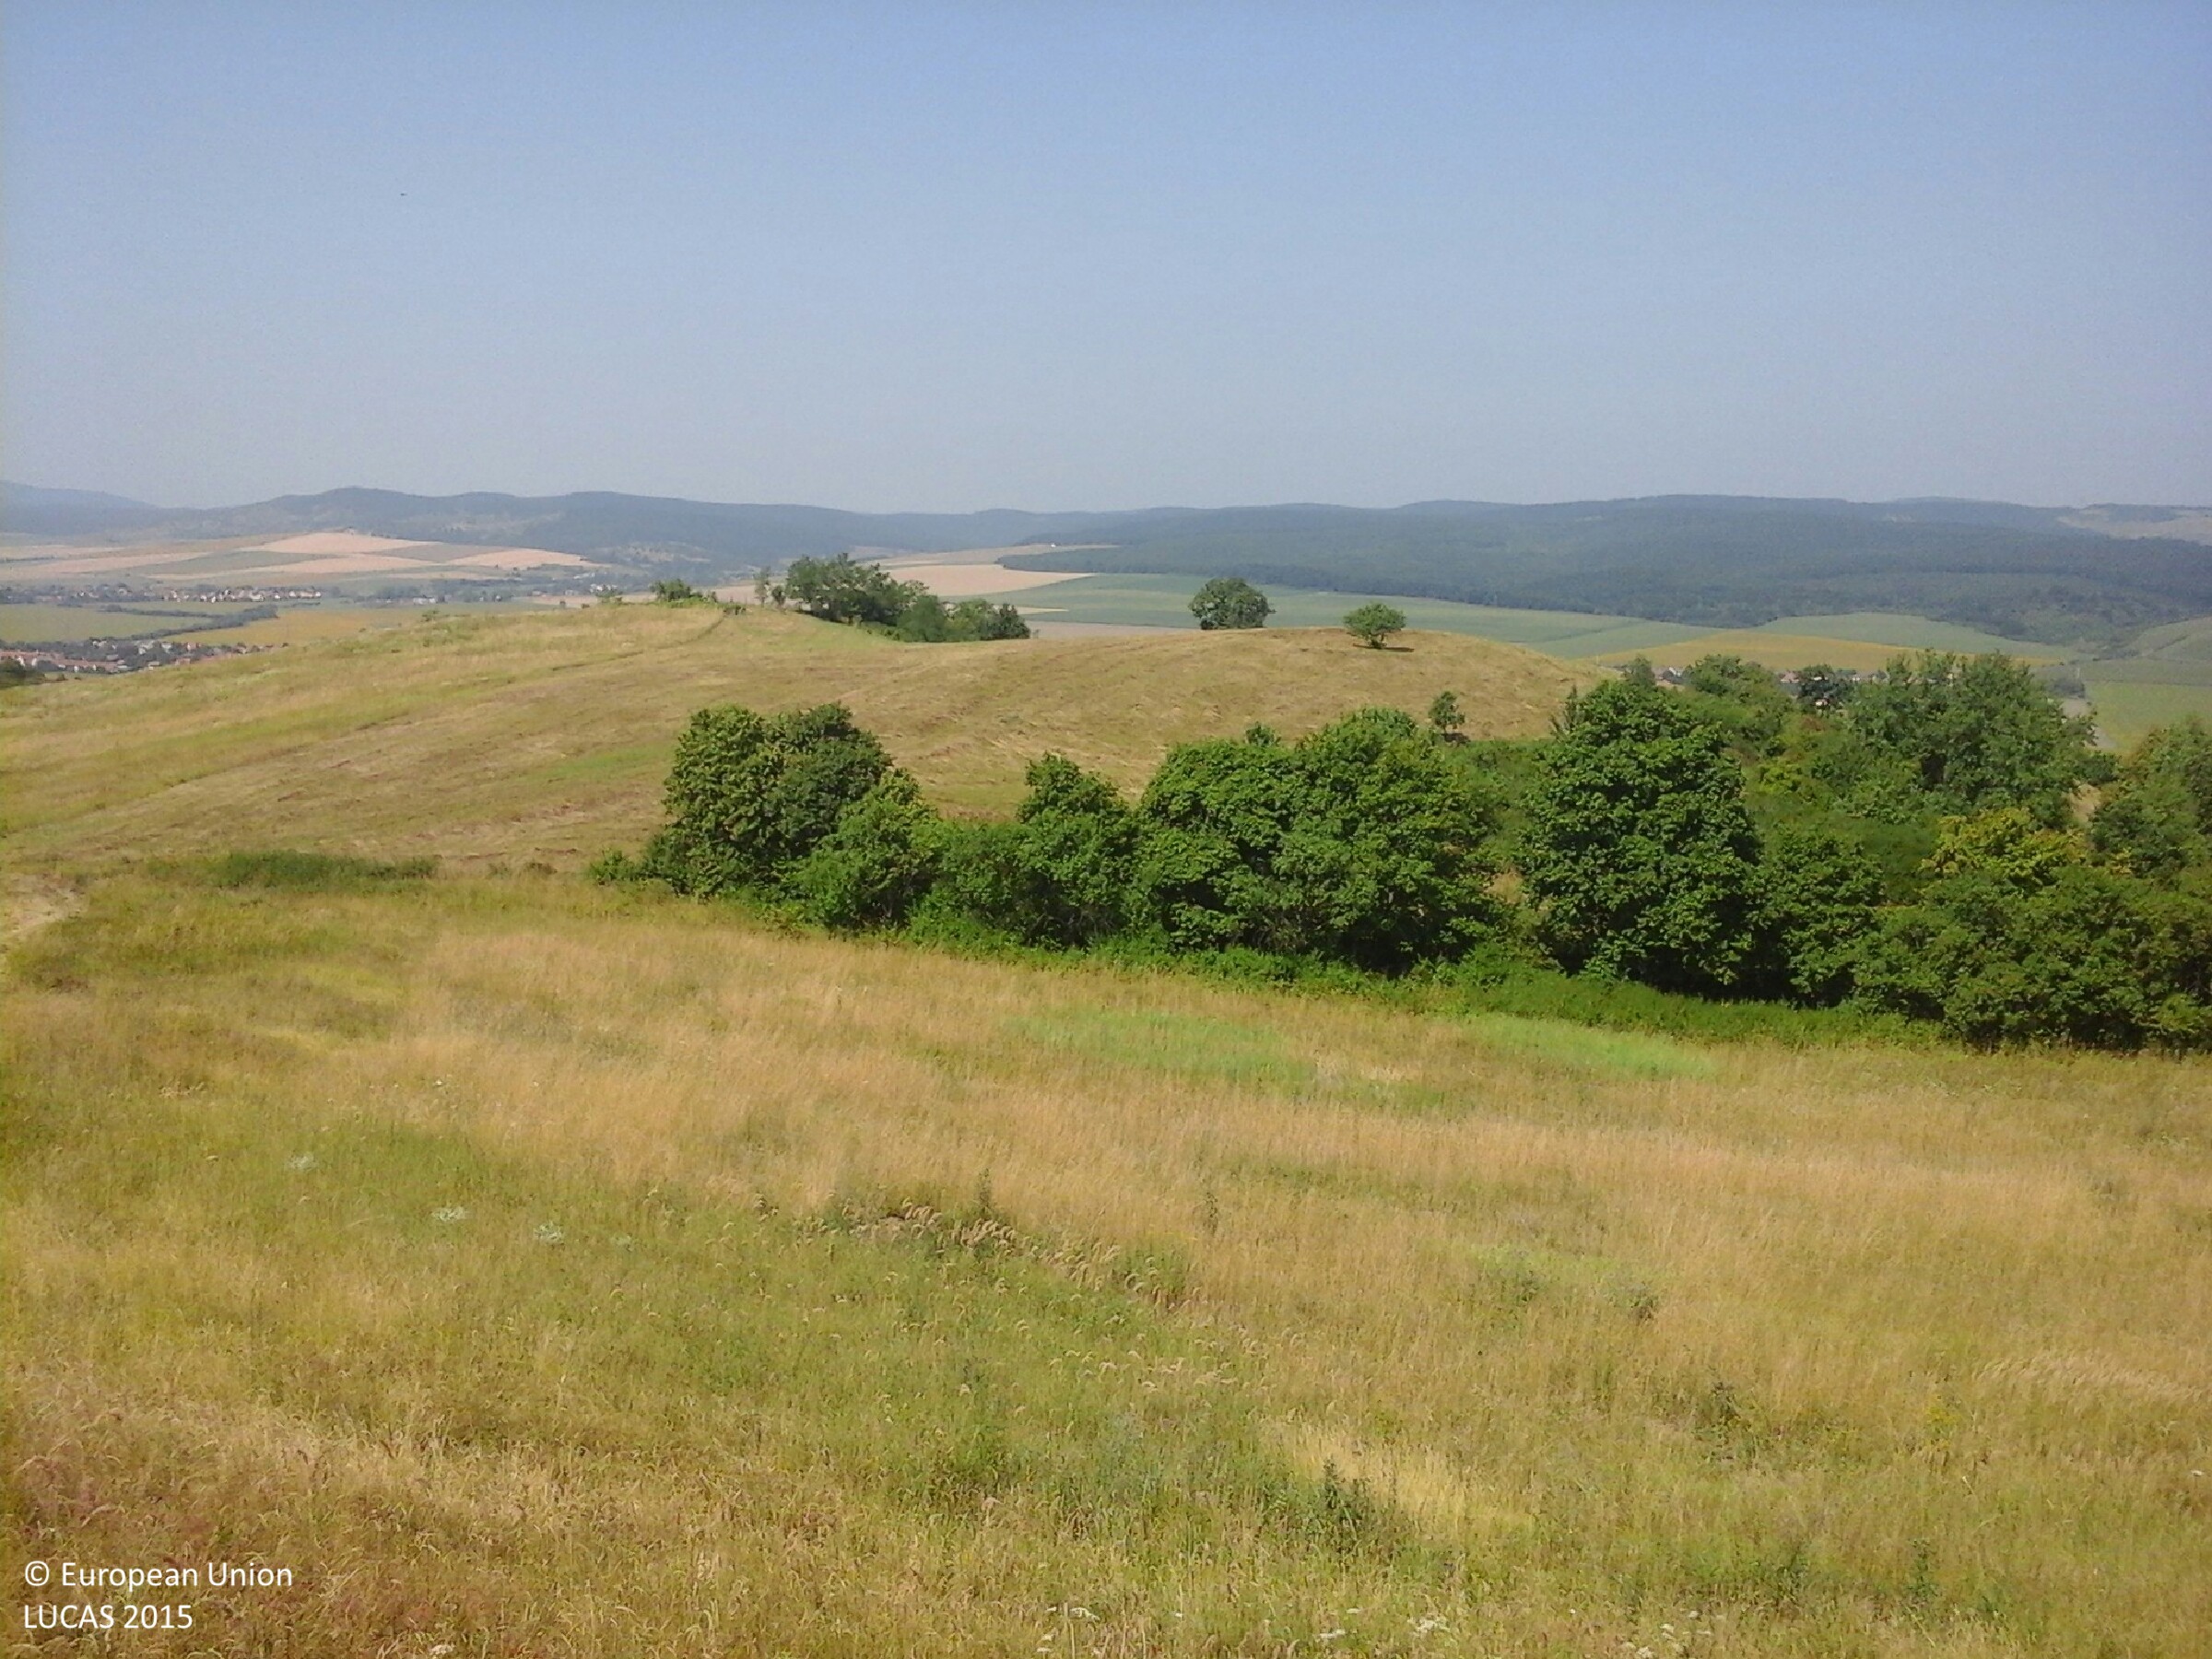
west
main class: Grassland
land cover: Grassland with sparse tree/shrub cover
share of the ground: > 75 %
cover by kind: herbaceous plants 95 %, broadleaved forest trees 5 %
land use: Abandoned areas
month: July
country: HU
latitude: 48.1909
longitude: 20.7037
